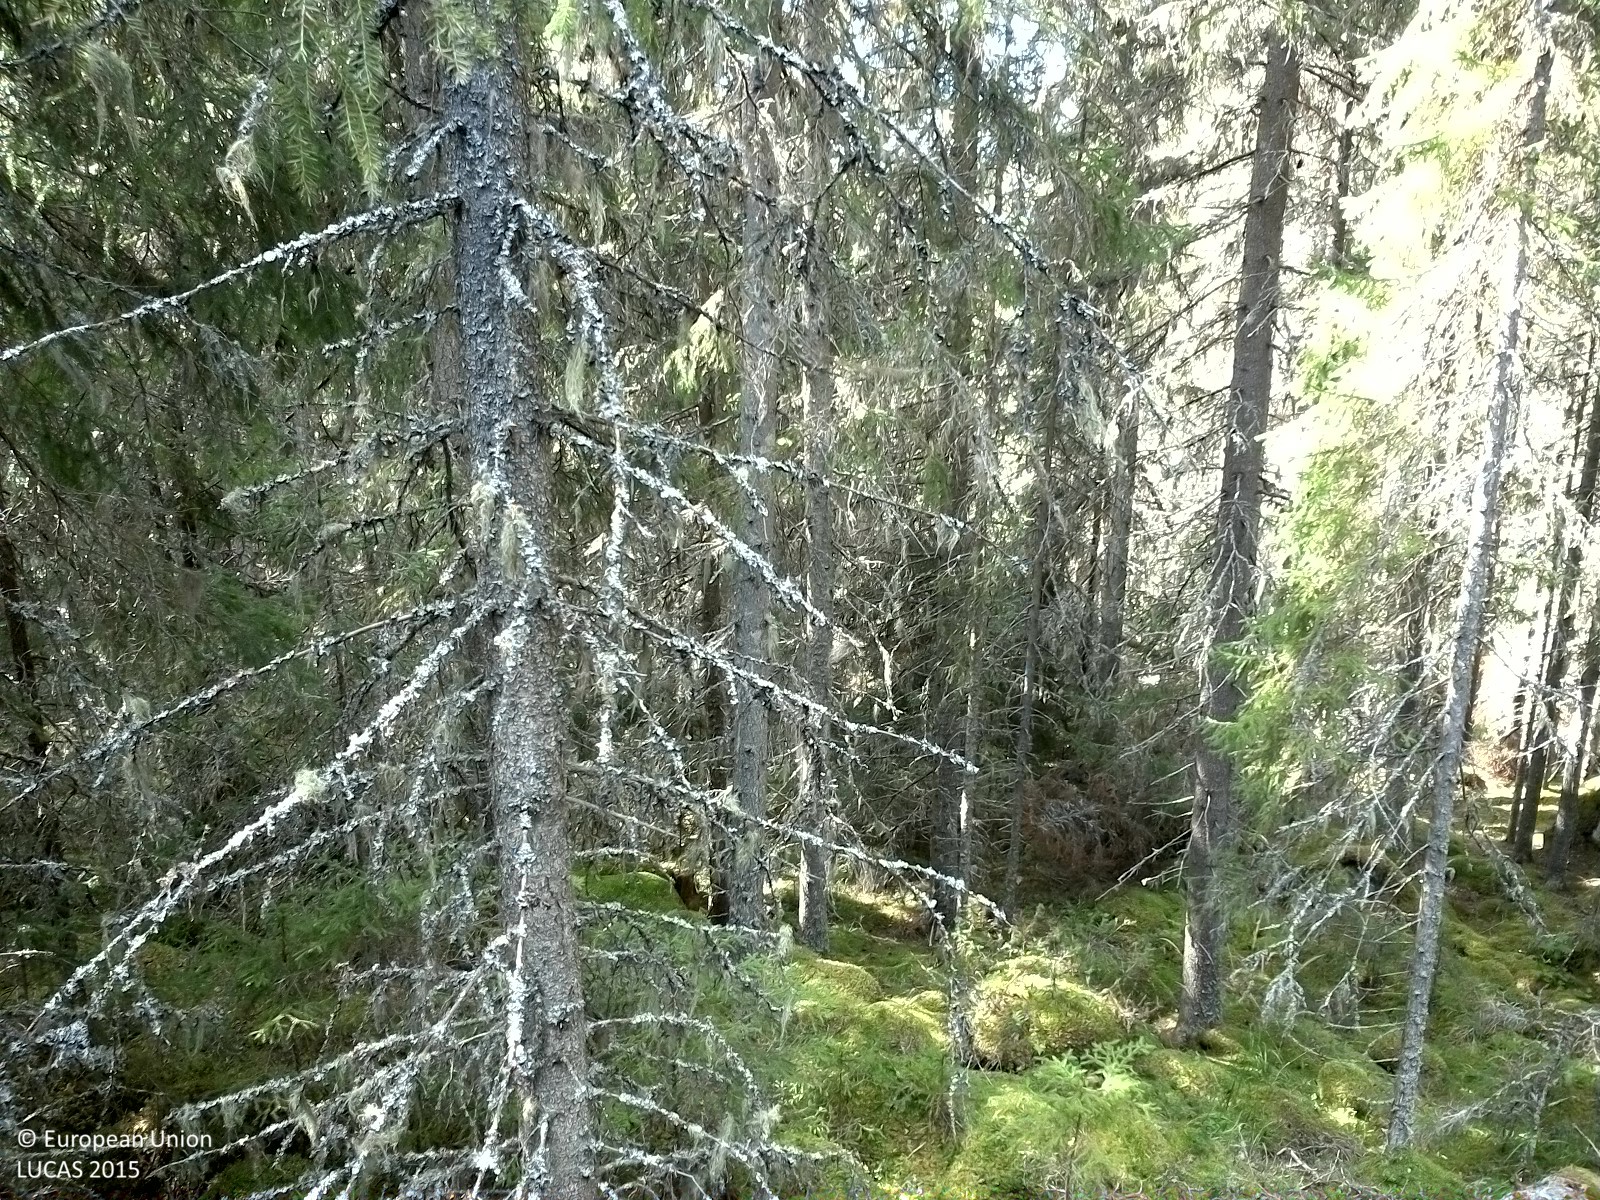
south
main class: Woodland
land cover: Spruce dominated coniferous woodland
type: boreal forest
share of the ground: > 75 %
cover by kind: coniferous forest trees 80 %, lichens and mosses 20 %
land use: Forestry
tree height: > 5 m
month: September
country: SE
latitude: 62.4567
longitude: 16.4344
